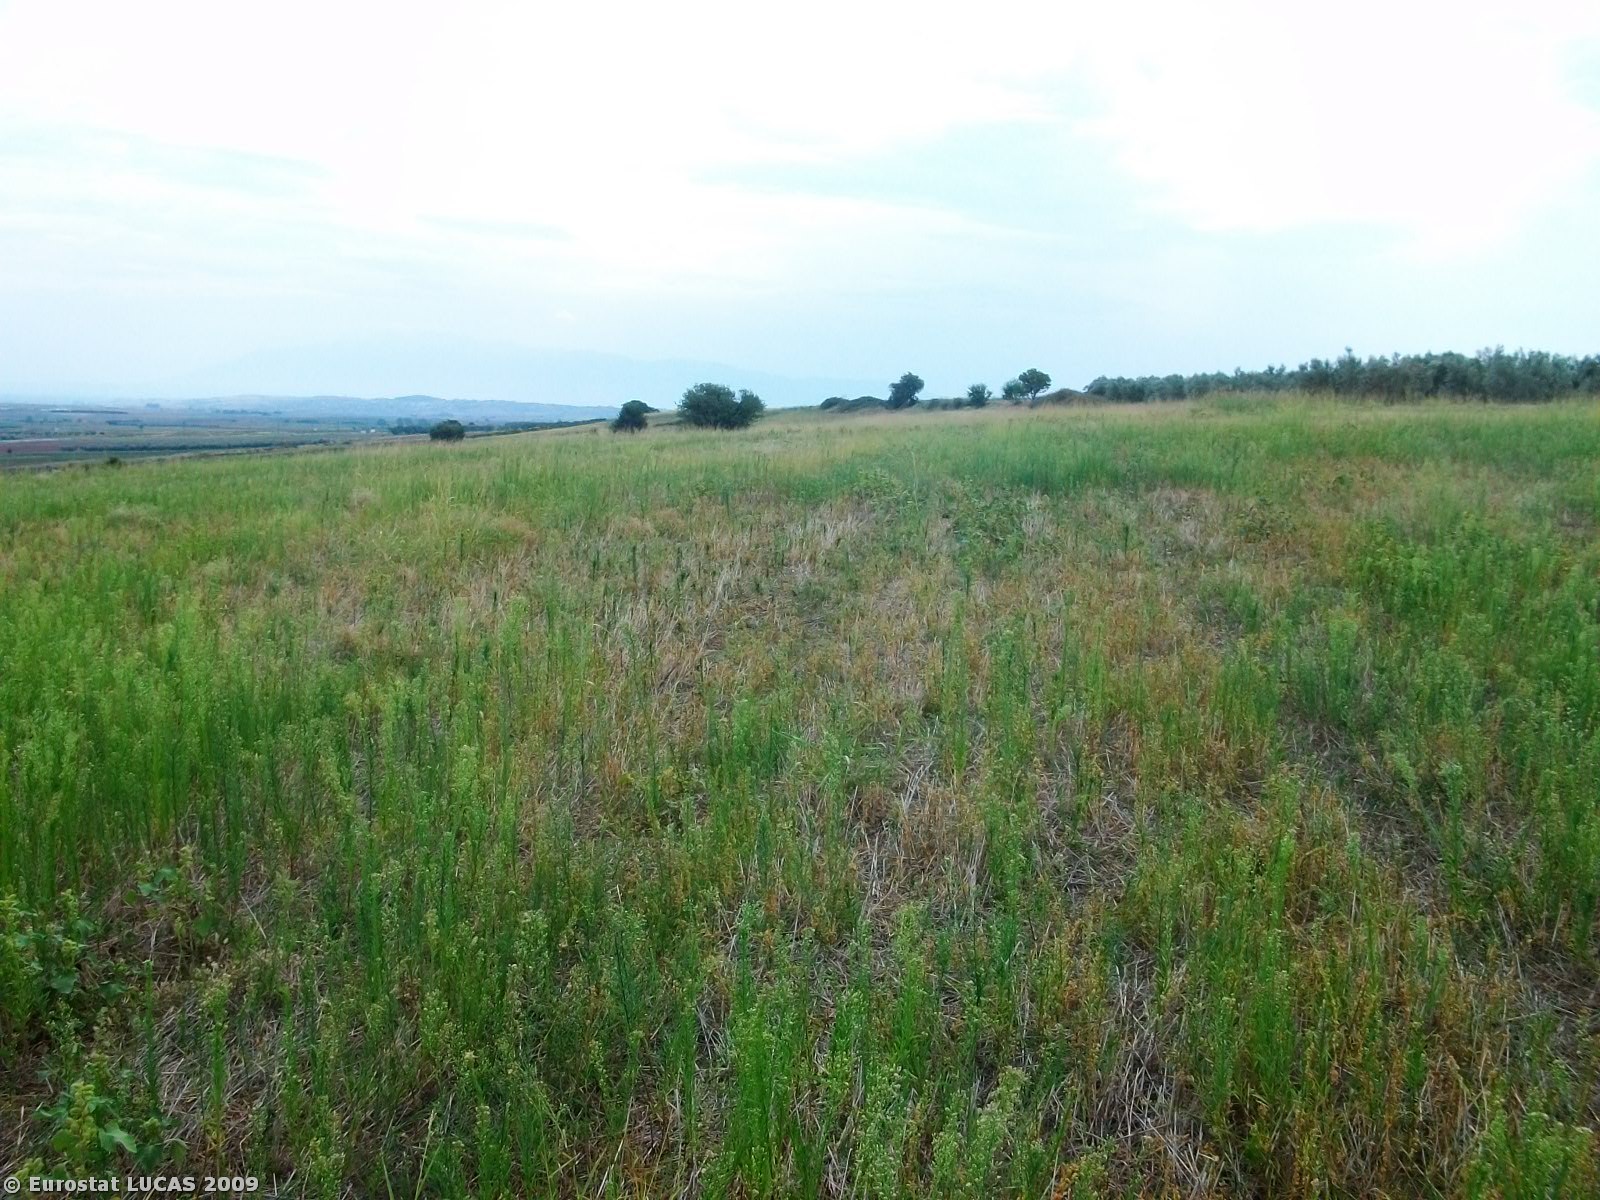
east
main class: Cropland
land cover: Durum wheat
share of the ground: 50 - 75 %
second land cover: Spontaneously vegetated surfaces
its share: 50 - 75 %
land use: Agriculture (excluding fallow land and kitchen gardens)
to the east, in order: Durum wheat; Spontaneously vegetated surfaces; Grass margins; Tracks; Grass margins; Bare land
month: September
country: GR
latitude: 40.8892
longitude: 23.6081
